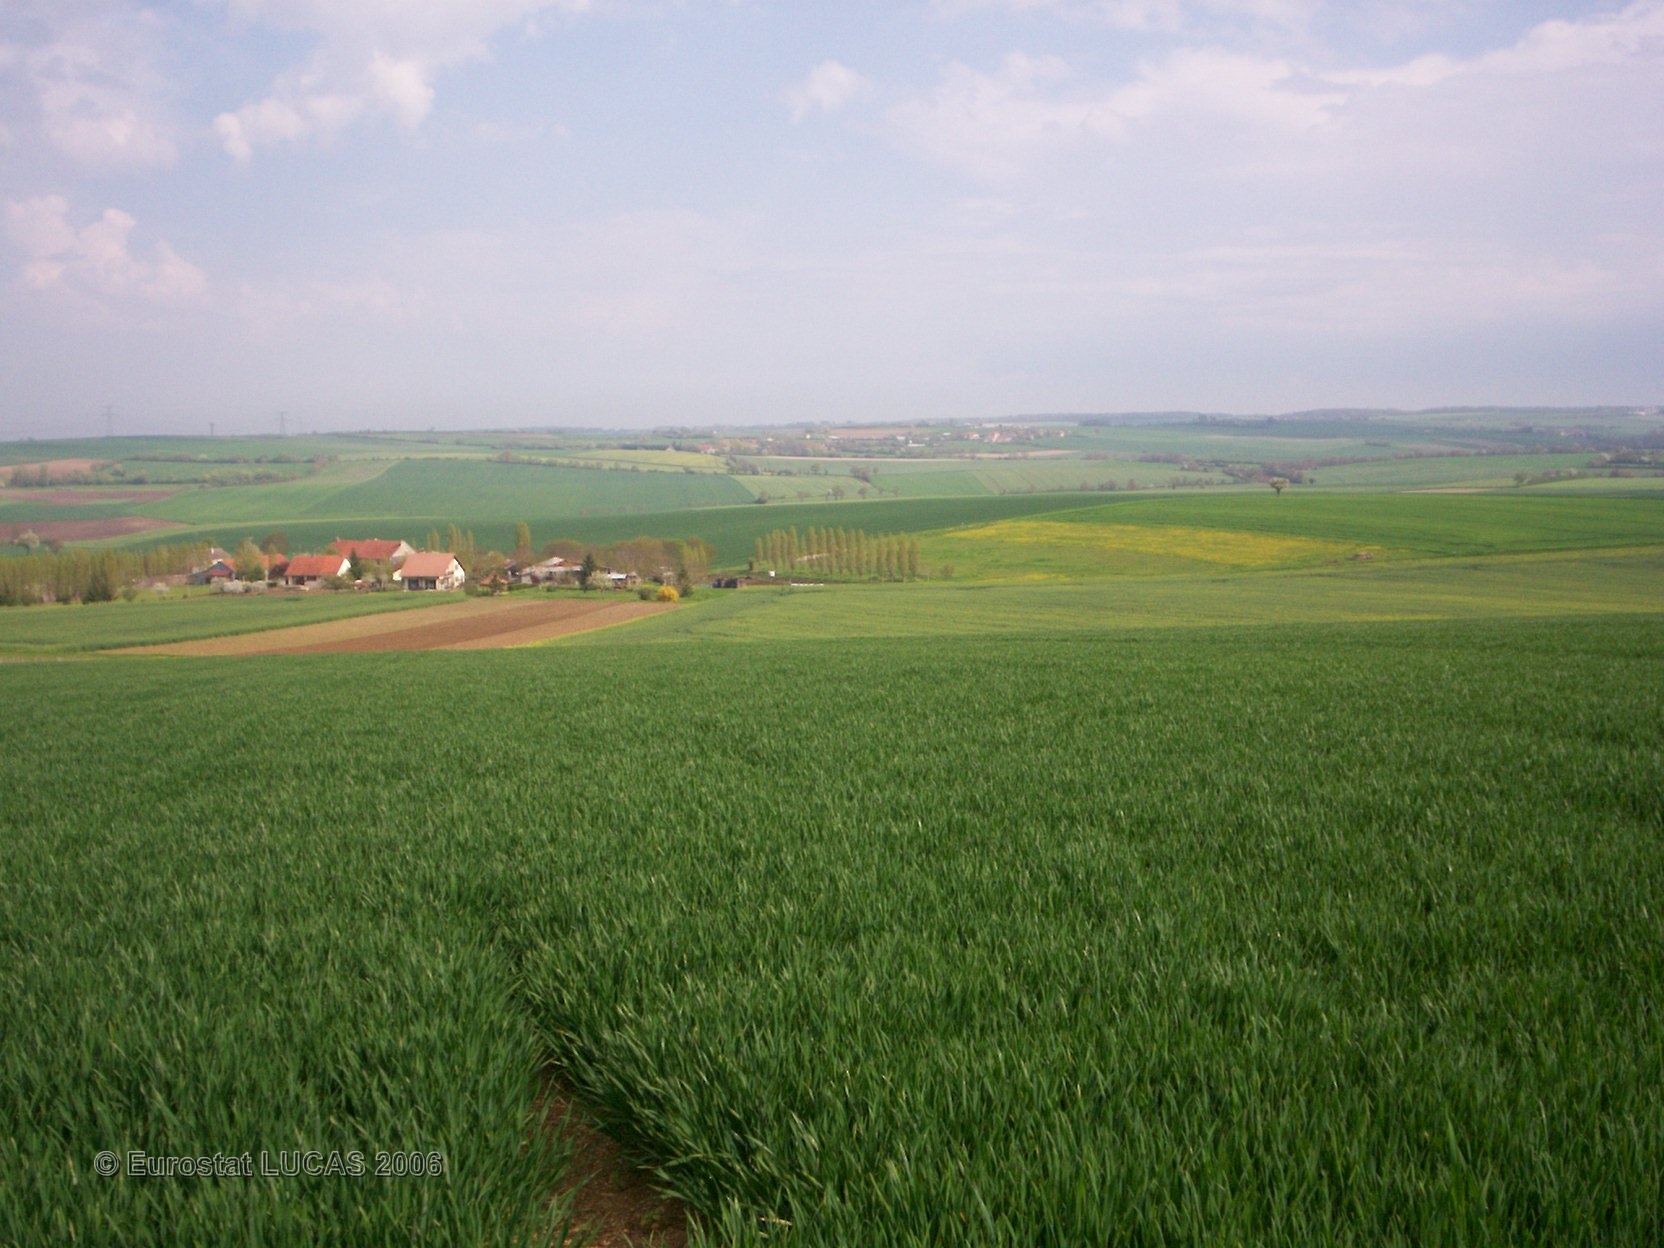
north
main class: Cropland
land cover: Common wheat
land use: Agriculture (excluding fallow land and kitchen gardens)
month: April
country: FR
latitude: 47.4055
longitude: 3.0110
